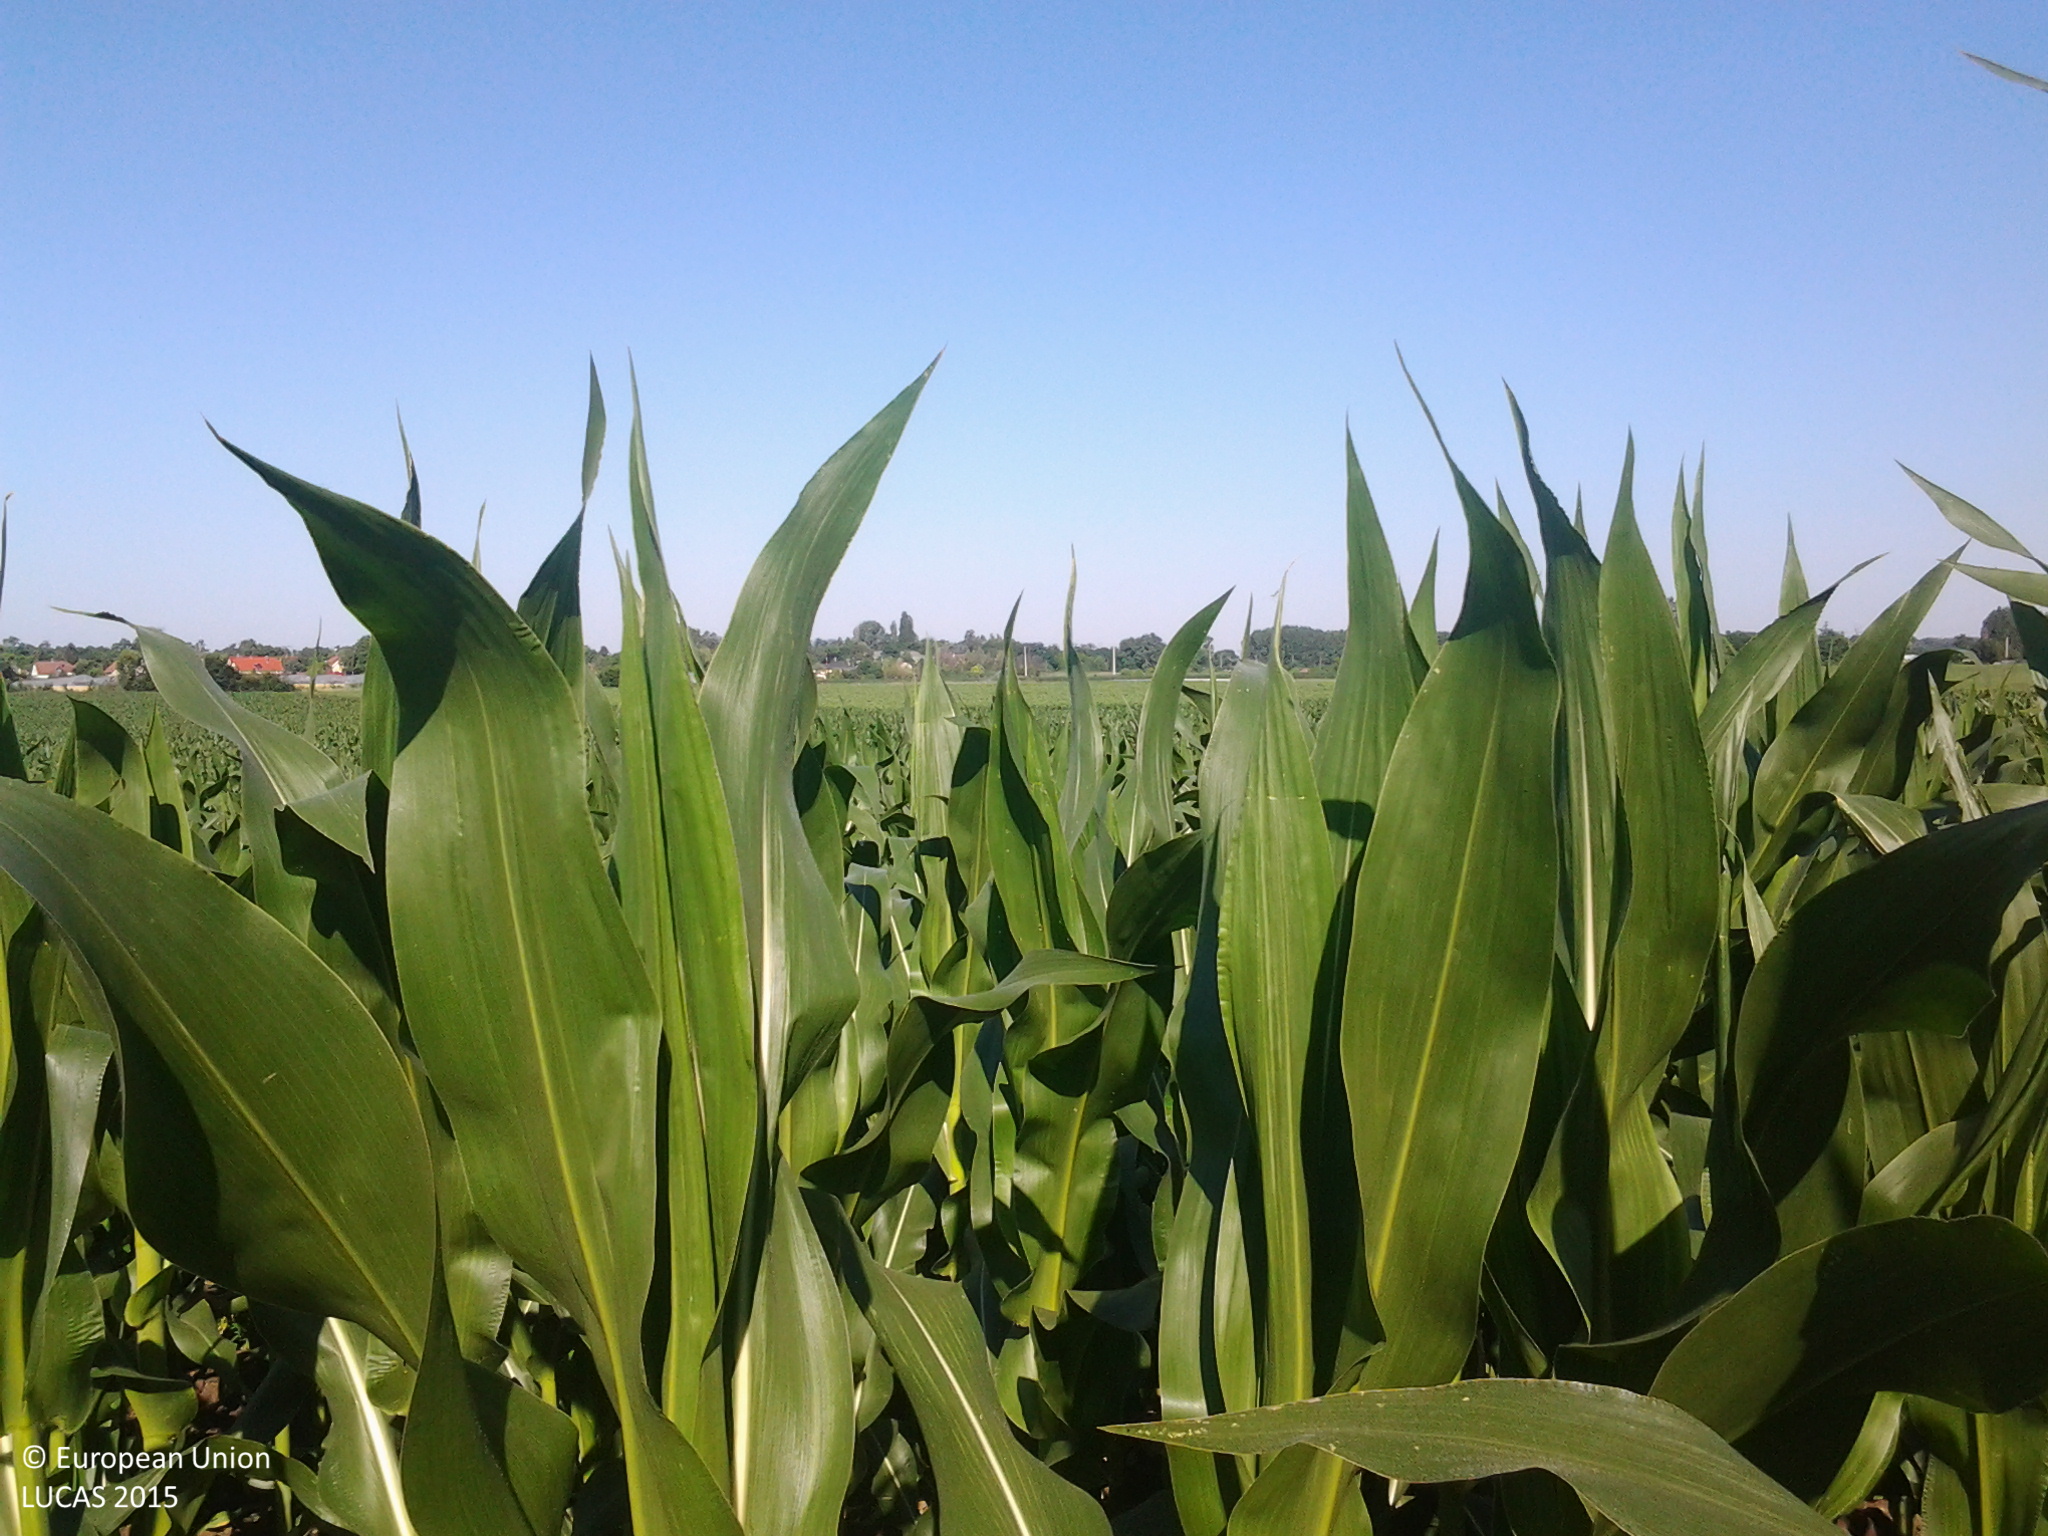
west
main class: Cropland
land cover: Maize
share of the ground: > 75 %
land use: Agriculture (excluding fallow land and kitchen gardens)
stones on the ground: < 10 %
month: June
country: HU
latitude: 46.9652
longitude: 19.6542
